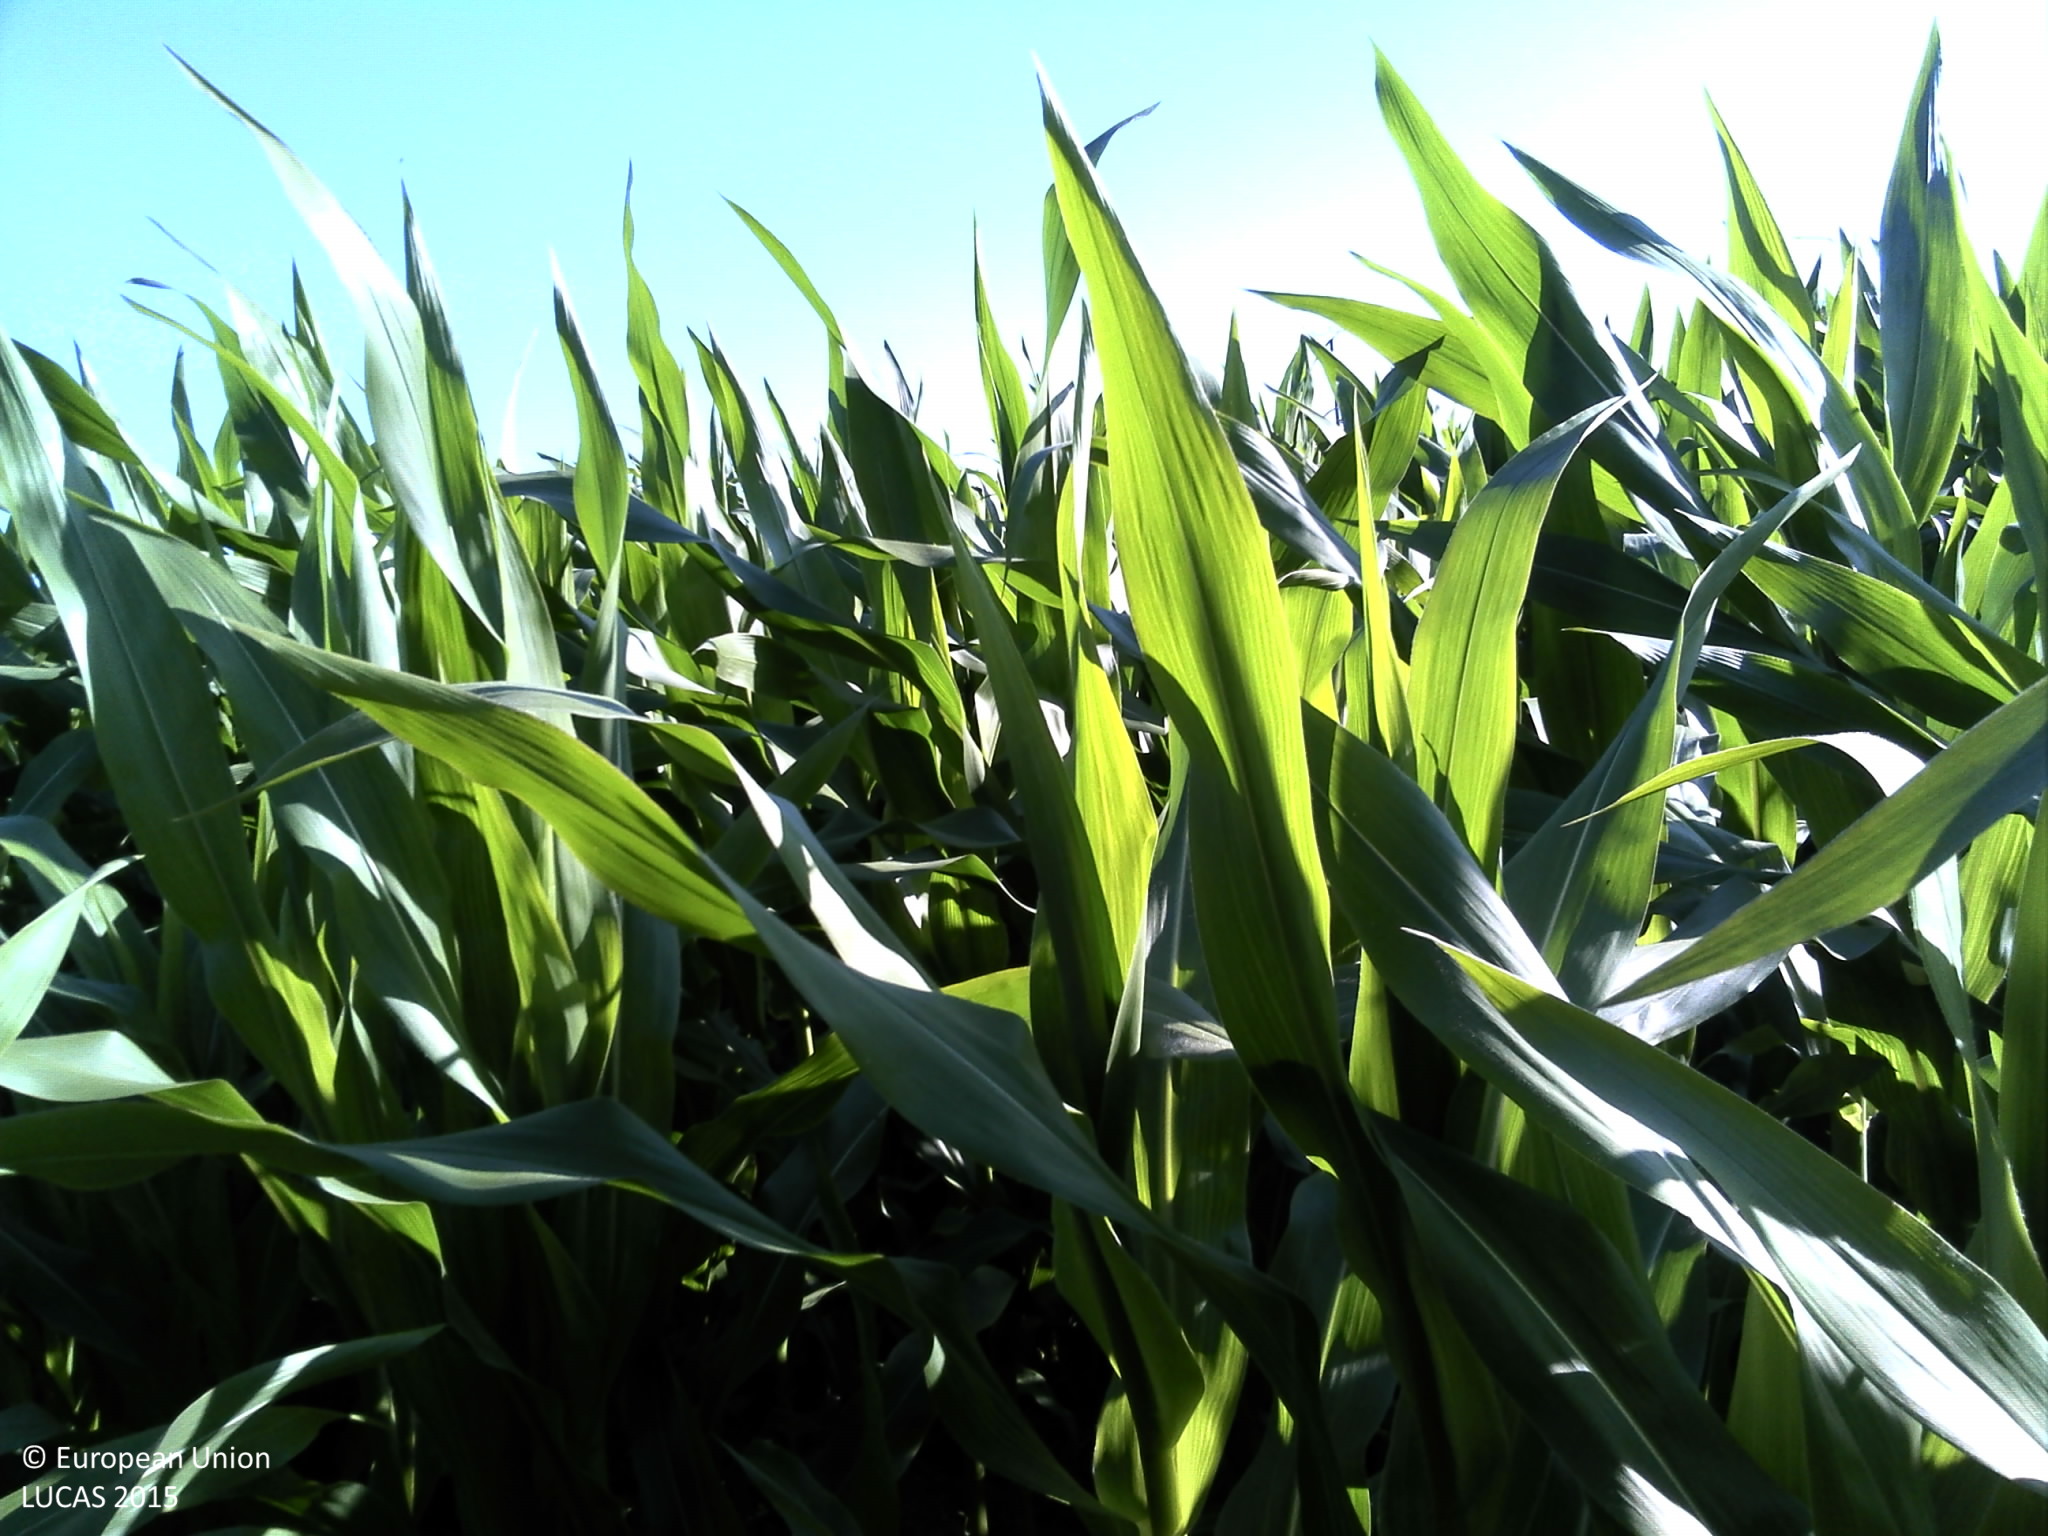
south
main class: Cropland
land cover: Maize
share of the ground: > 75 %
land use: Agriculture (excluding fallow land and kitchen gardens)
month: July
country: FR
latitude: 48.5384
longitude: -4.4964
